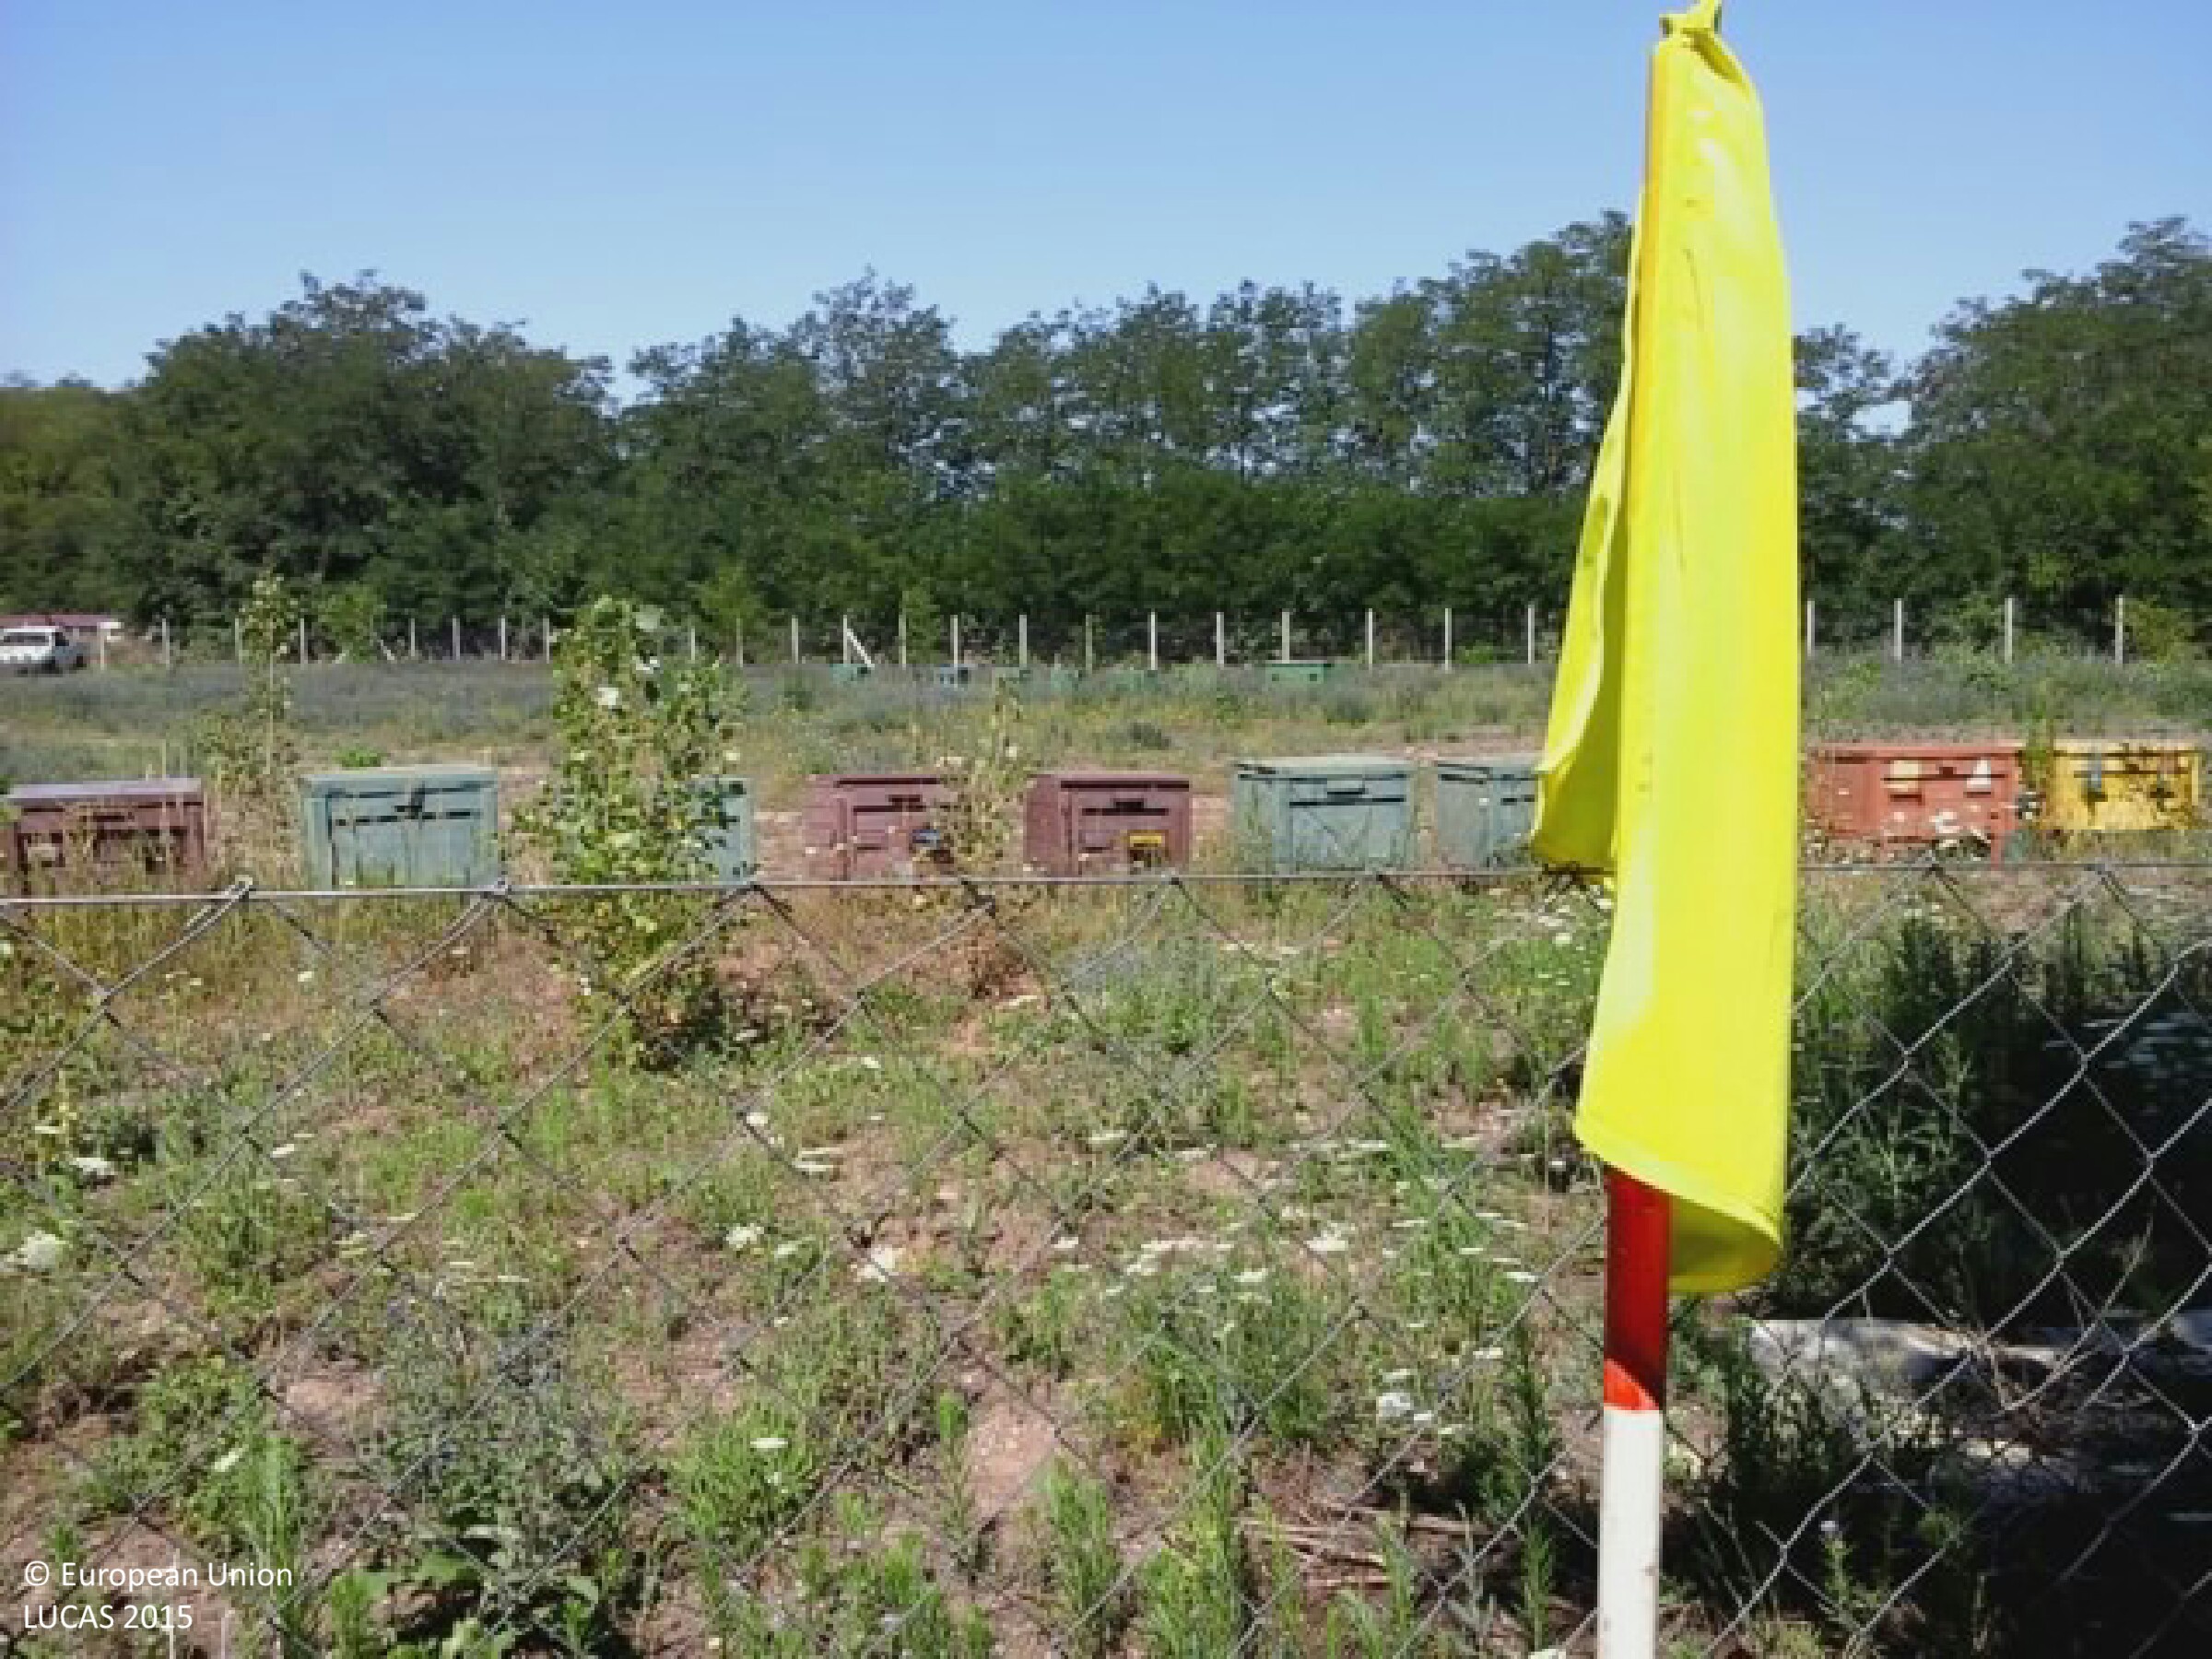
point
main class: Grassland
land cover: Spontaneously vegetated surfaces
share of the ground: > 75 %
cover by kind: herbaceous plants 100 %
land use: Agriculture (excluding fallow land and kitchen gardens)
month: July
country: HU
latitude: 48.2620
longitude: 20.7189
